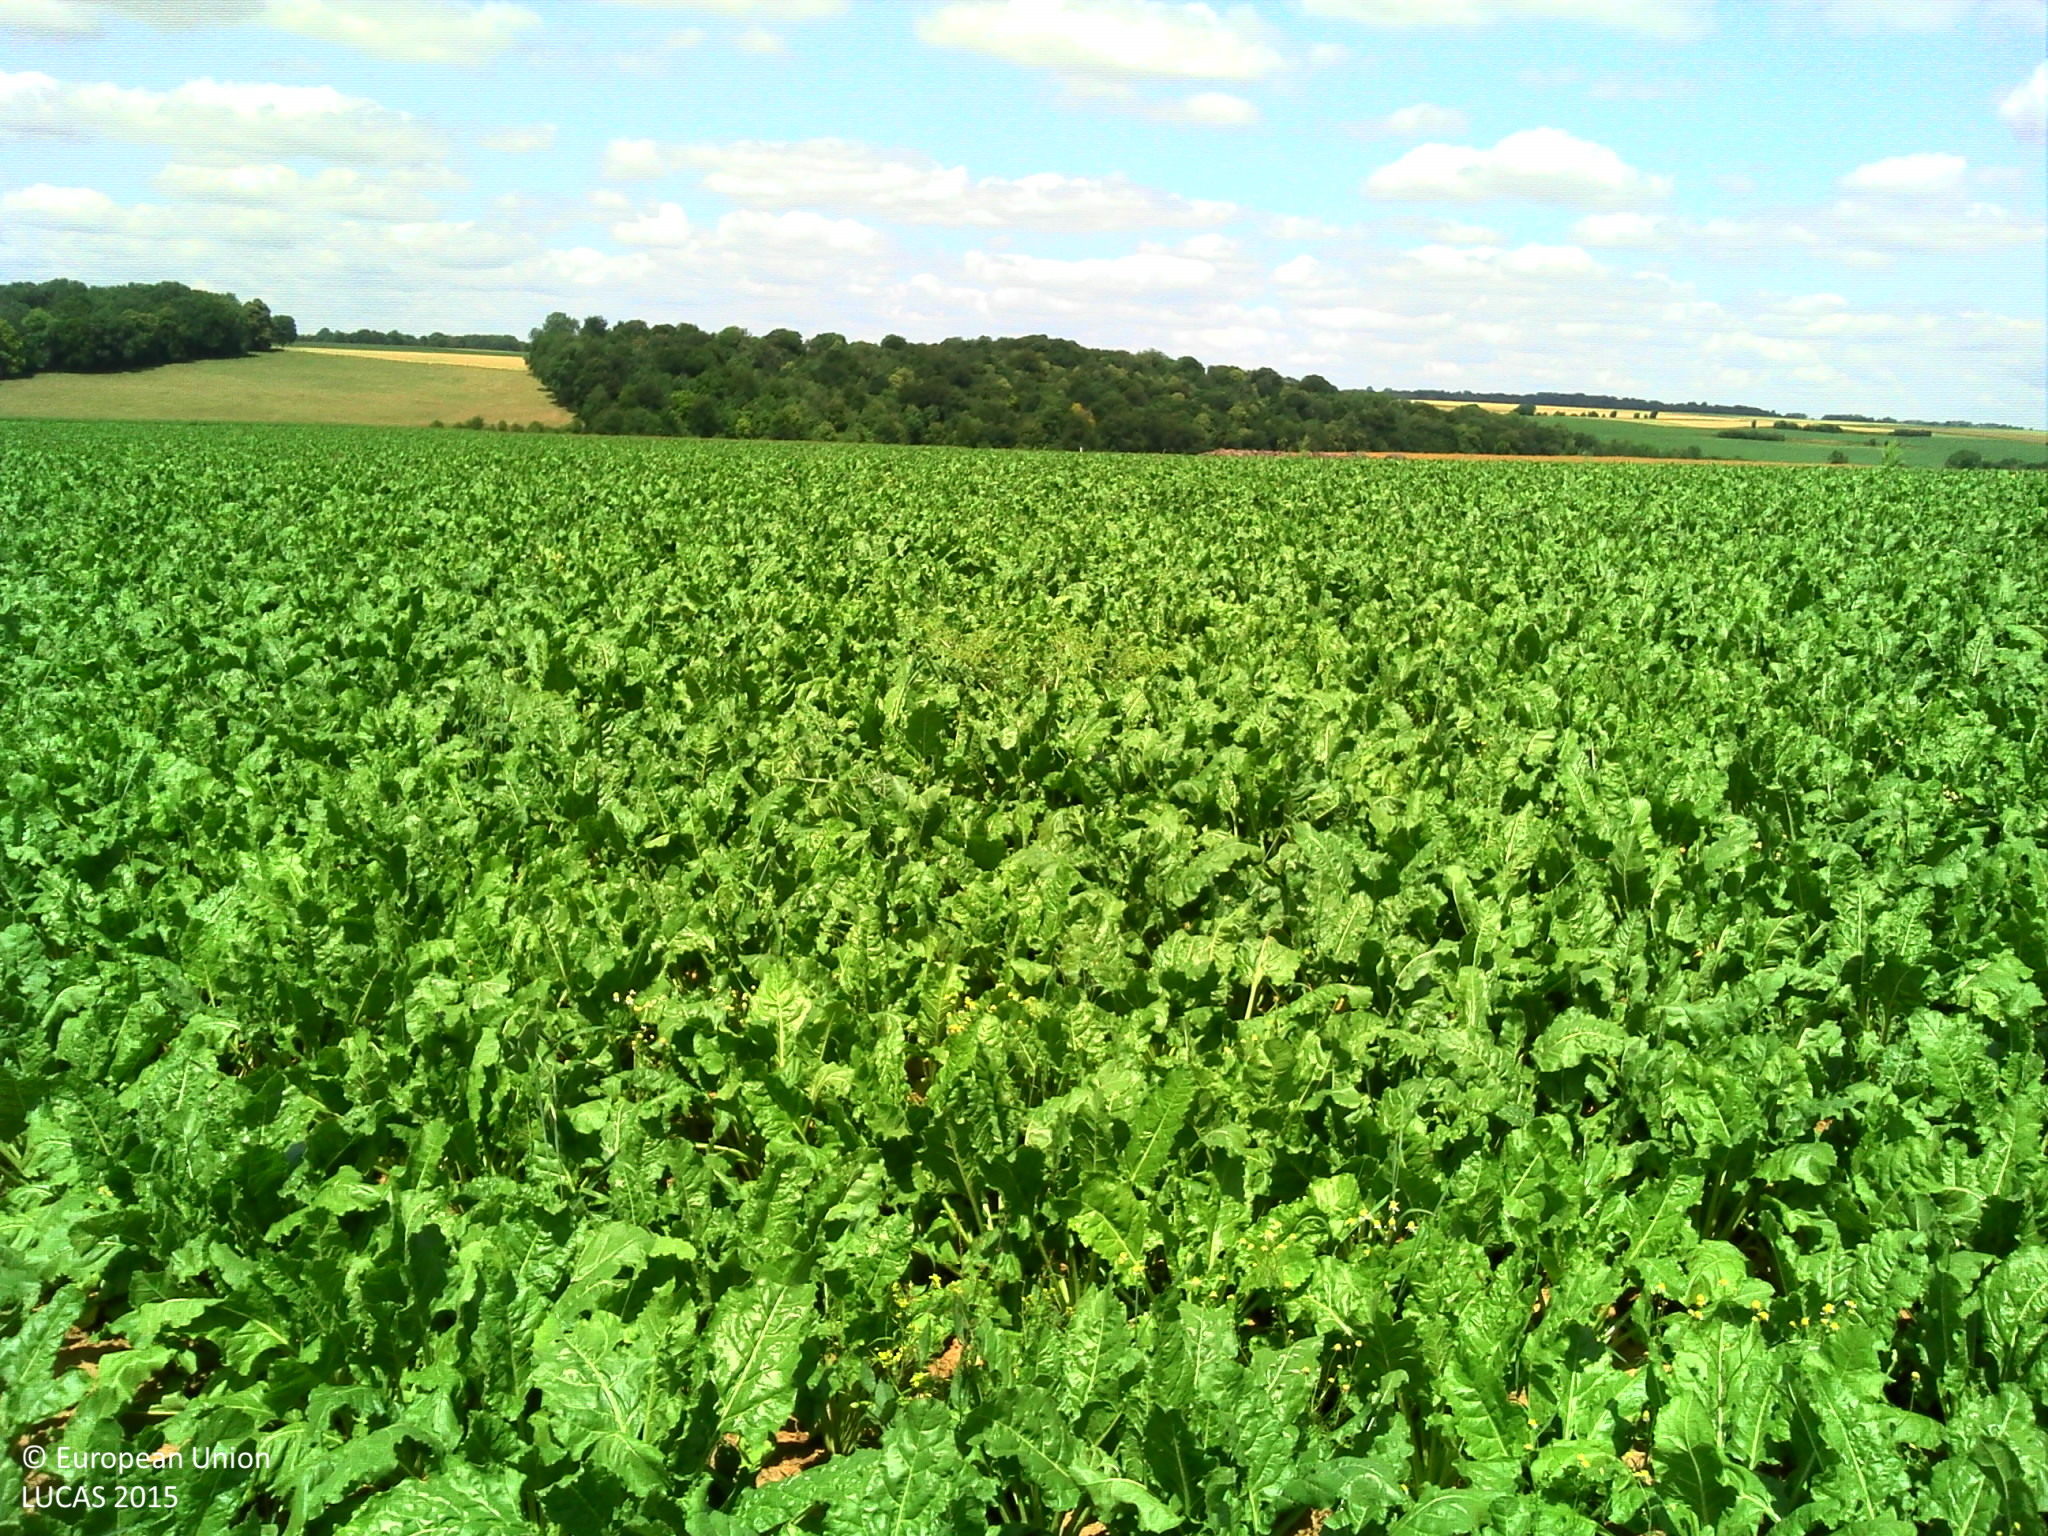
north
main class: Cropland
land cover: Sugar beet
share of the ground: > 75 %
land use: Agriculture (excluding fallow land and kitchen gardens)
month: July
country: FR
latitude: 50.3494
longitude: 2.1858
